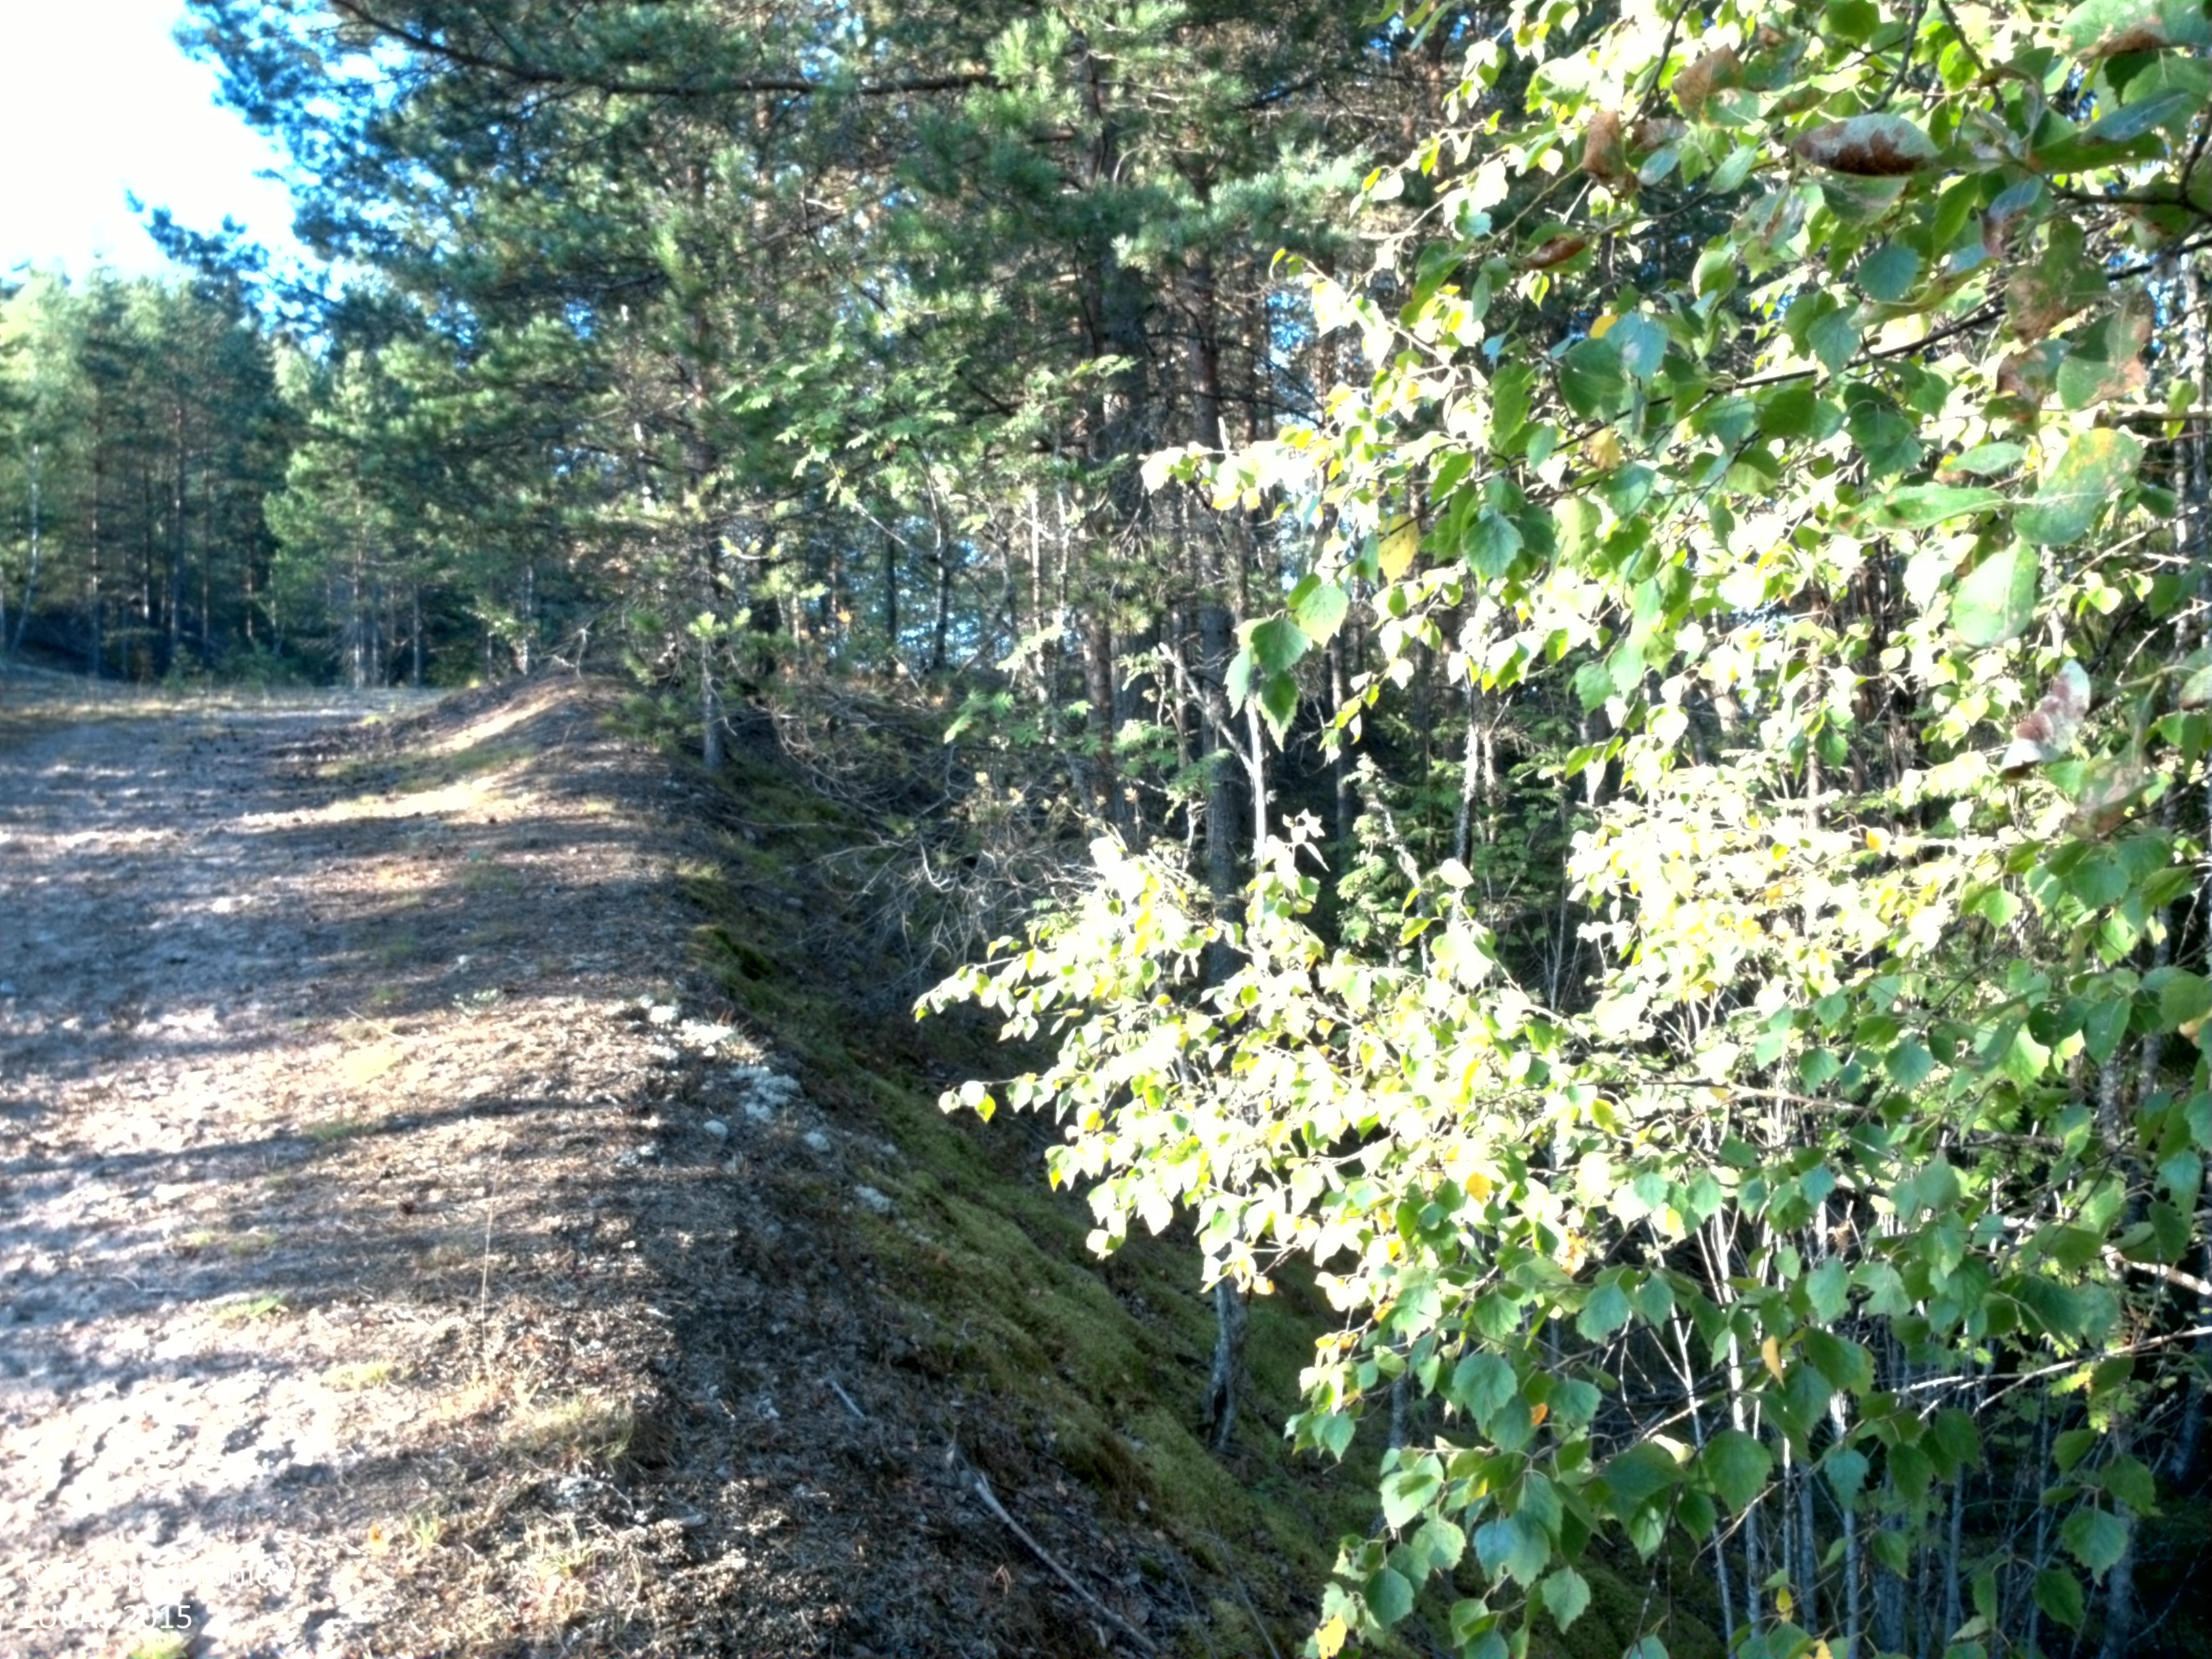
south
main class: Woodland
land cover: Pine dominated mixed woodland
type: boreal forest
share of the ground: 25 - 50 %
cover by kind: coniferous forest trees 35 %, lichens and mosses 25 %, consolidated bare surface 20 %, broadleaved forest trees 15 %, herbaceous plants 5 %
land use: Sport
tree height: > 5 m
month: August
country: SE
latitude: 59.5288
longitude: 13.3335
